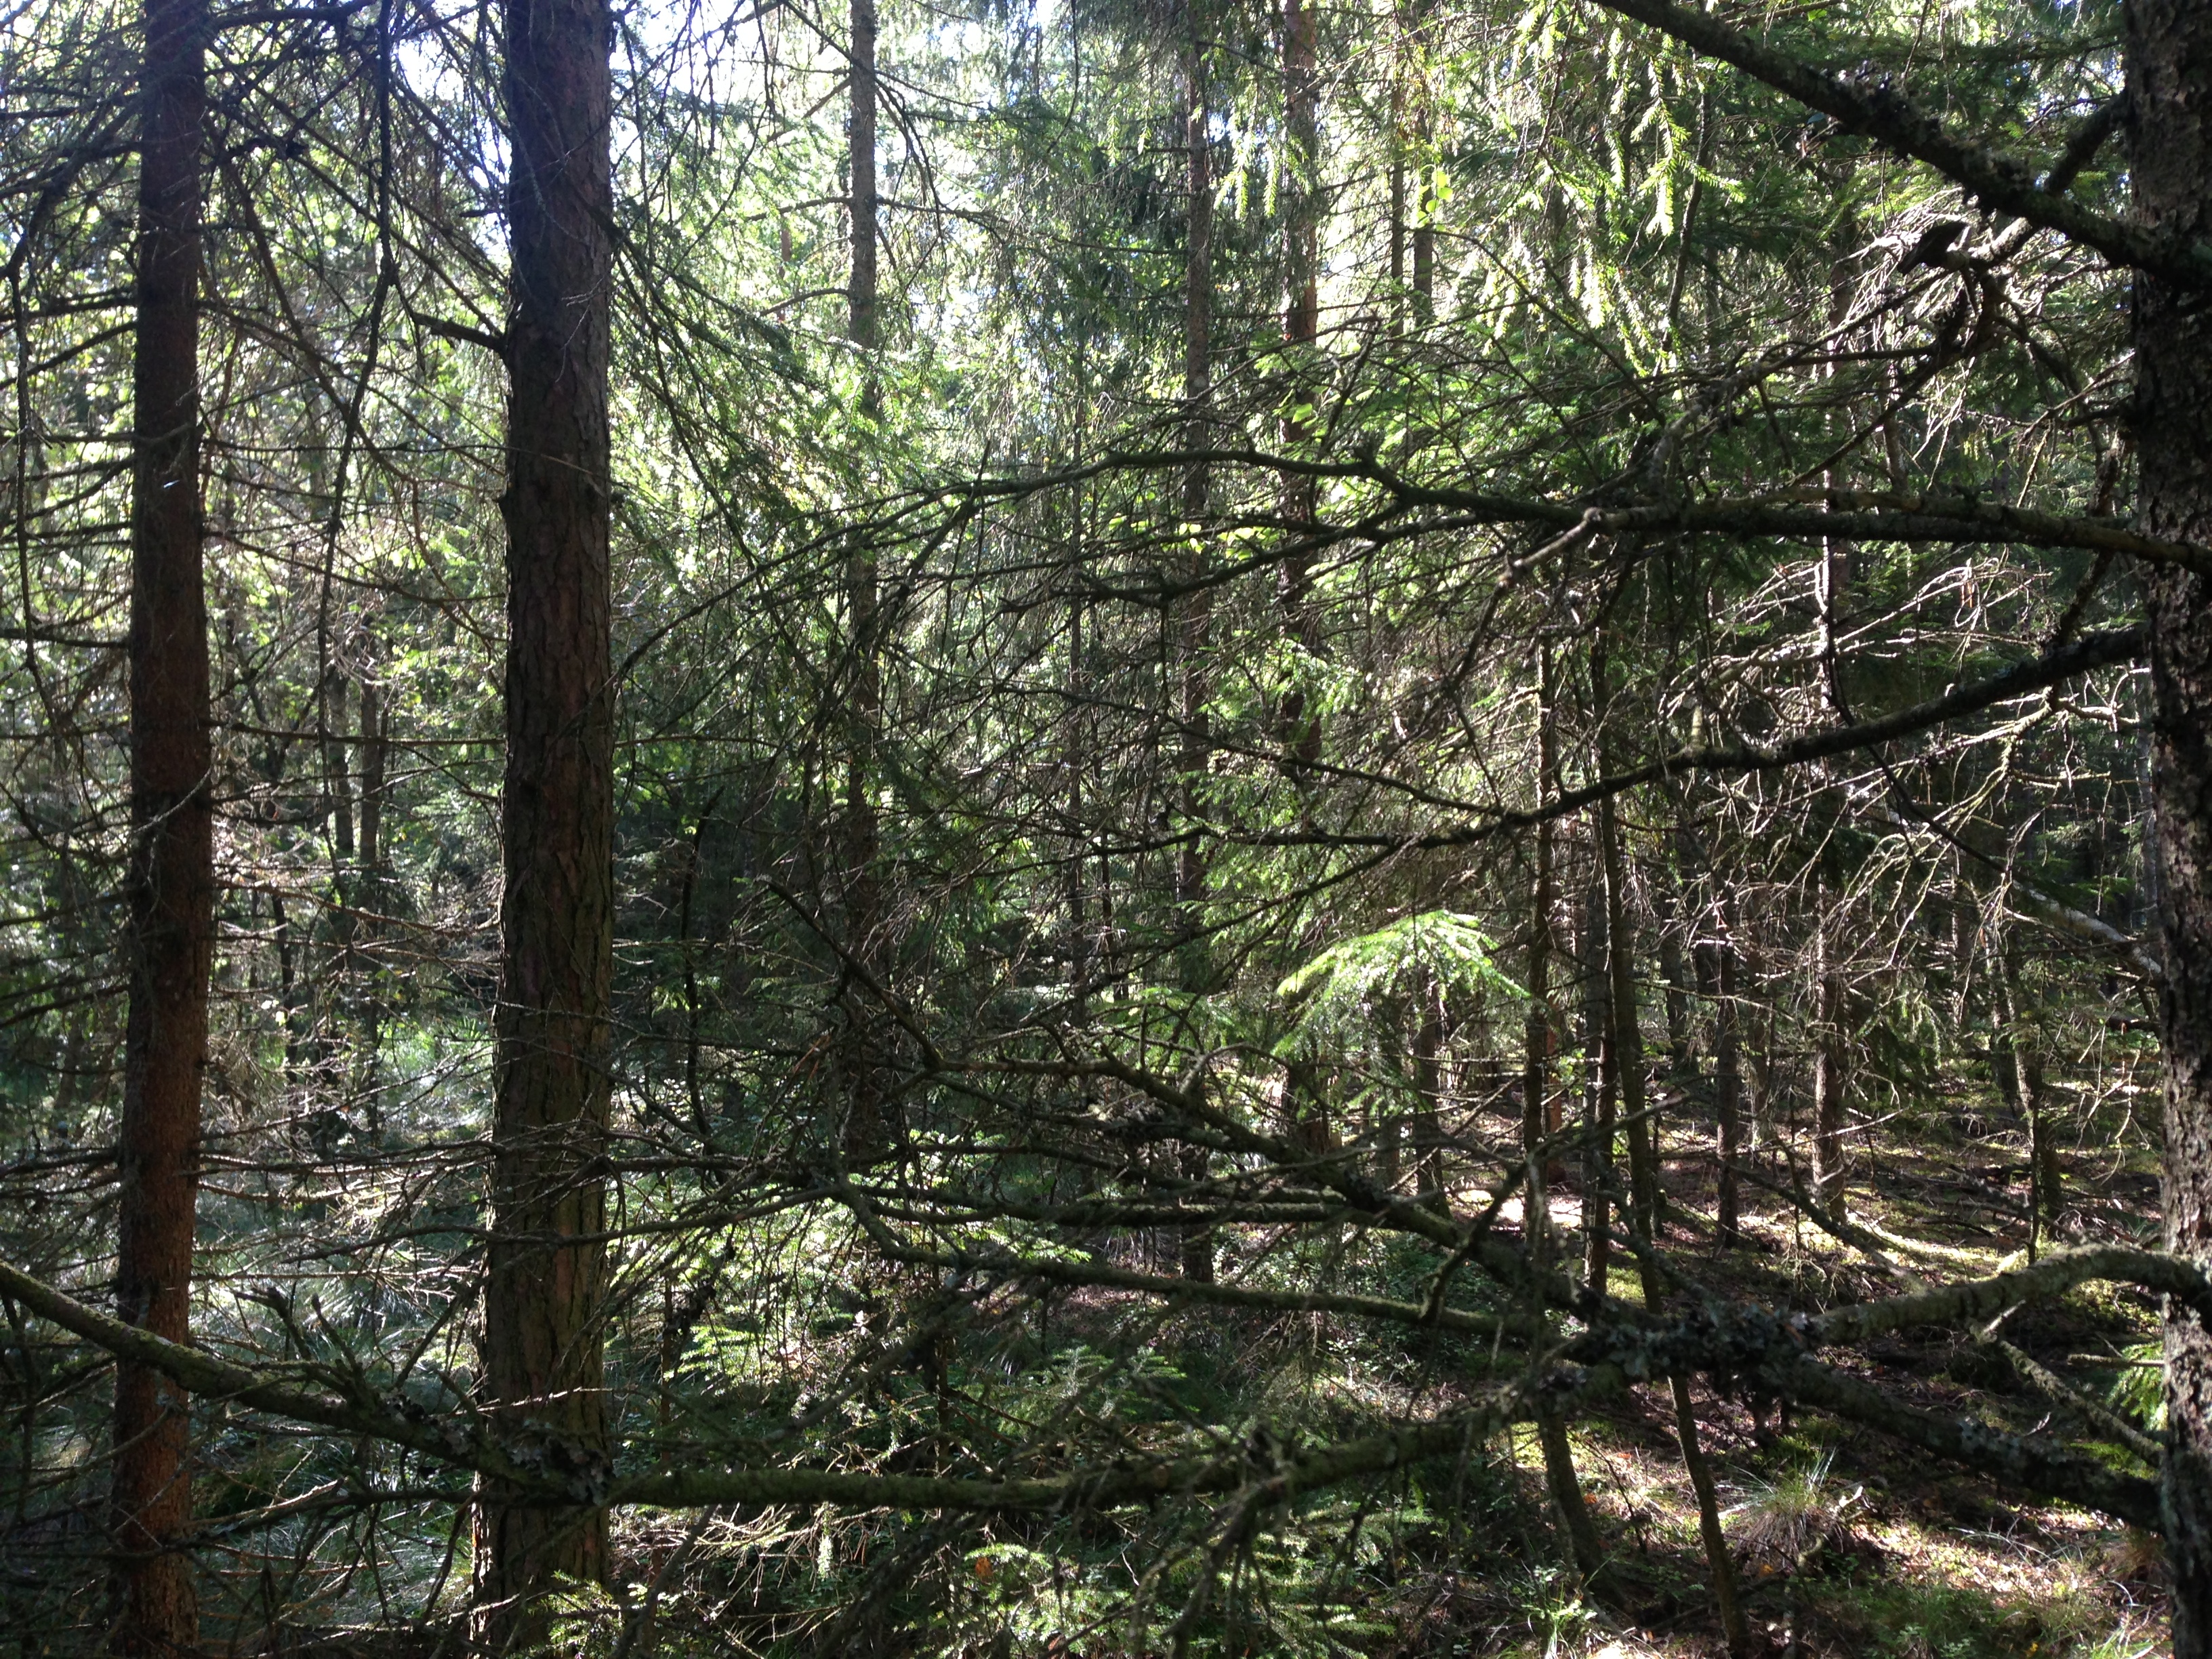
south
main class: Woodland
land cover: Pine dominated mixed woodland
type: boreal forest
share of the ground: > 75 %
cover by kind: coniferous forest trees 50 %, broadleaved forest trees 30 %, shrubs 20 %
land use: Forestry
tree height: > 5 m
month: September
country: SE
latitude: 57.1183
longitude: 13.2497
